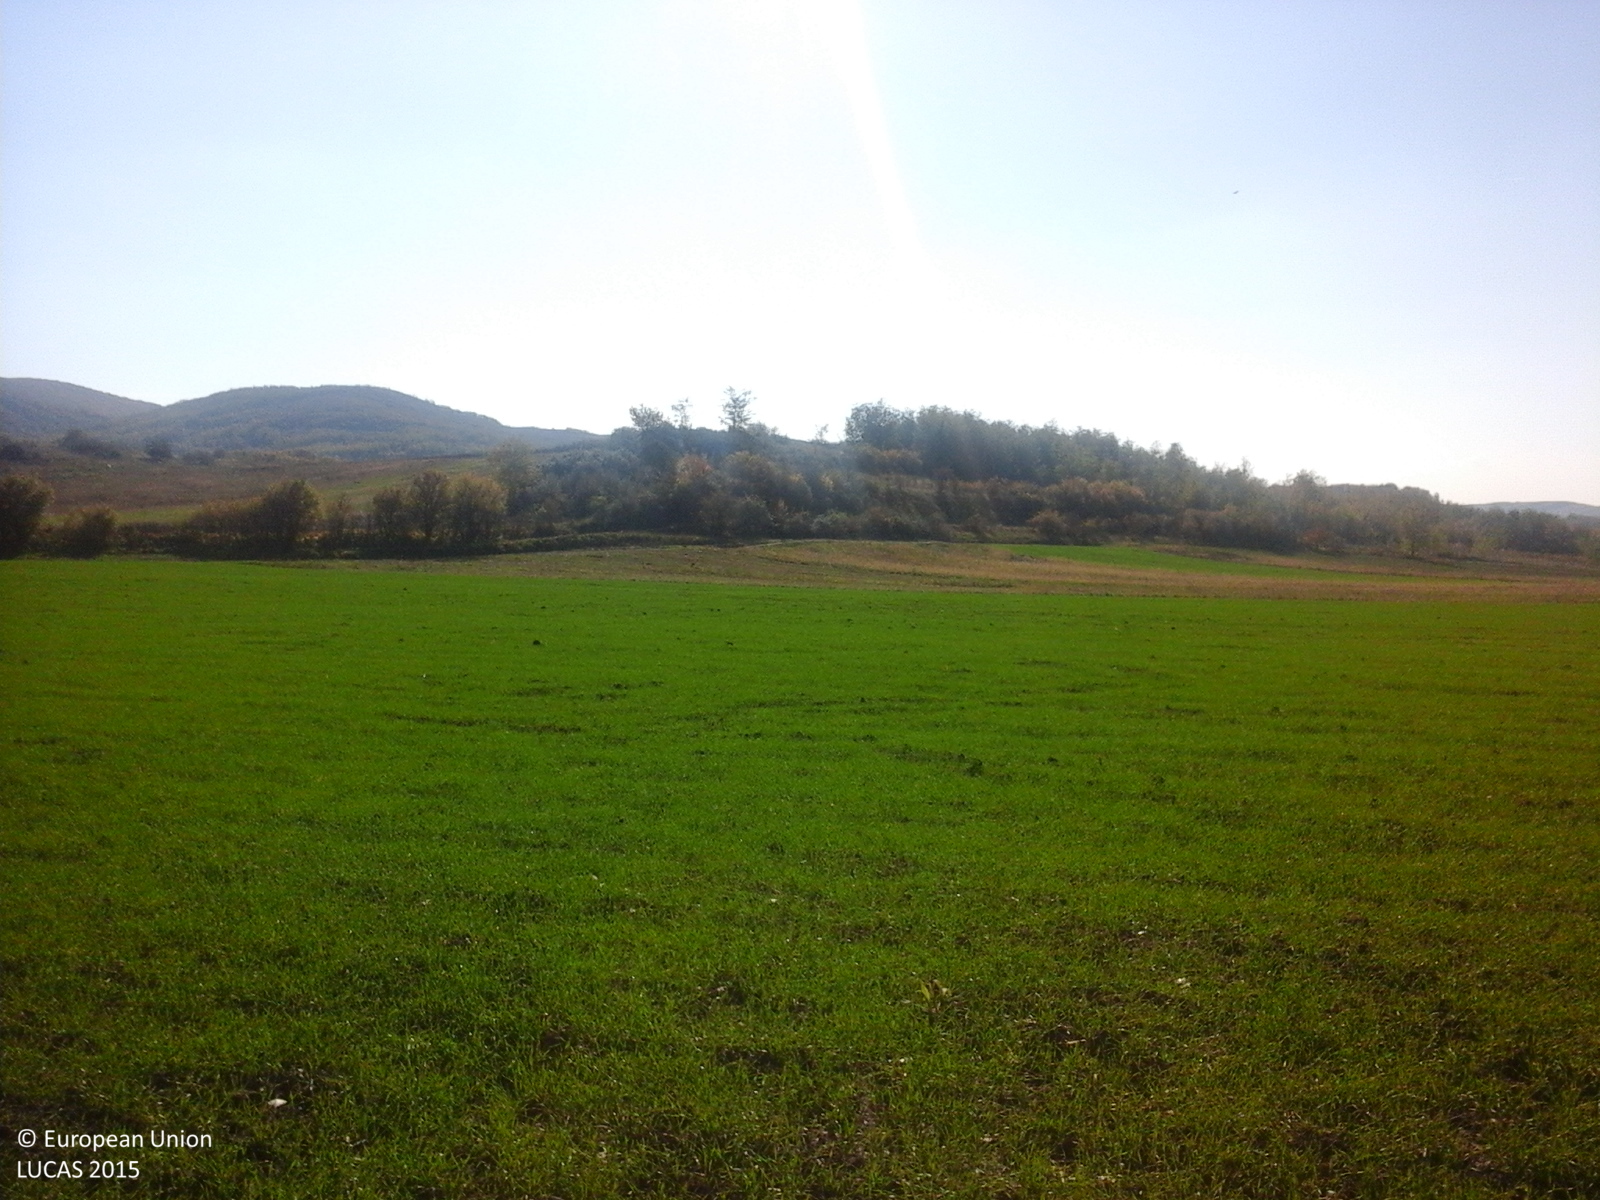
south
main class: Cropland
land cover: Common wheat
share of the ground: > 75 %
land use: Agriculture (excluding fallow land and kitchen gardens)
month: October
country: RO
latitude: 45.3258
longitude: 26.7810
